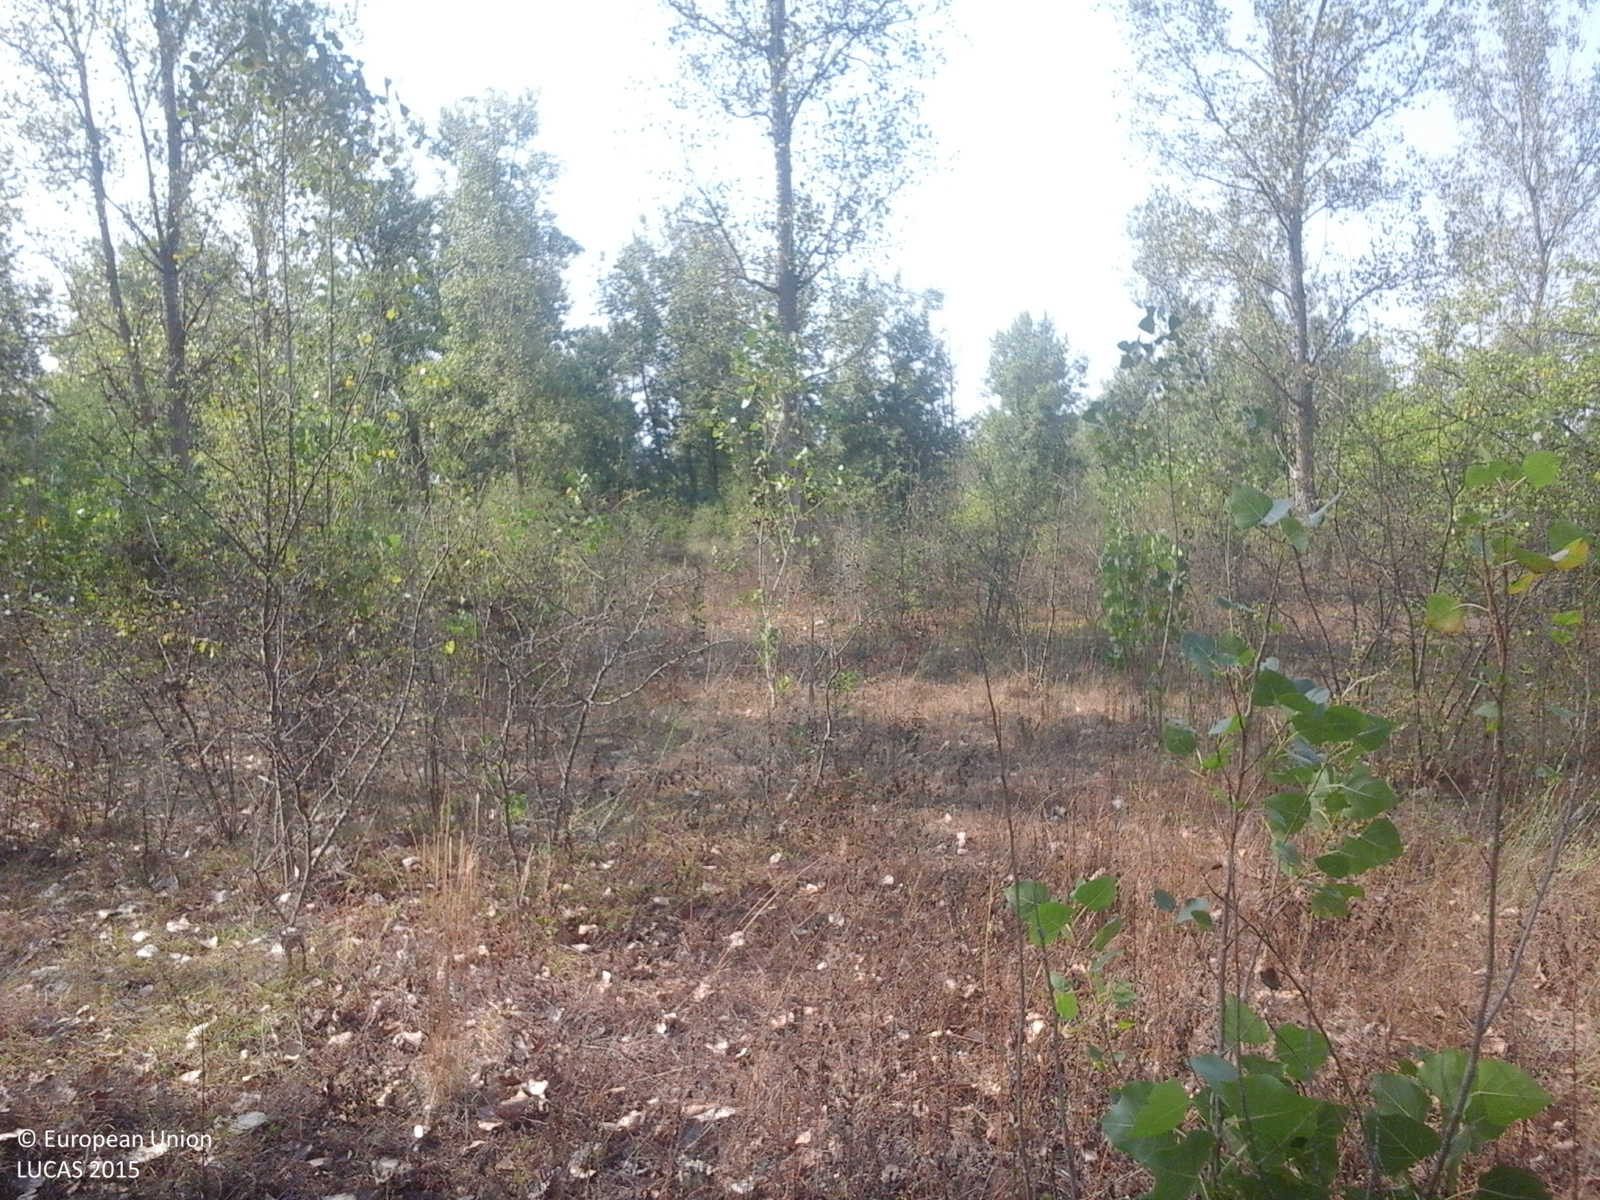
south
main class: Grassland
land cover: Grassland with sparse tree/shrub cover
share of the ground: > 75 %
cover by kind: herbaceous plants 85 %, shrubs 10 %, broadleaved forest trees 5 %
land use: Fallow land
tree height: < 5 m
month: August
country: RO
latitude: 44.7946
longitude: 23.5184
